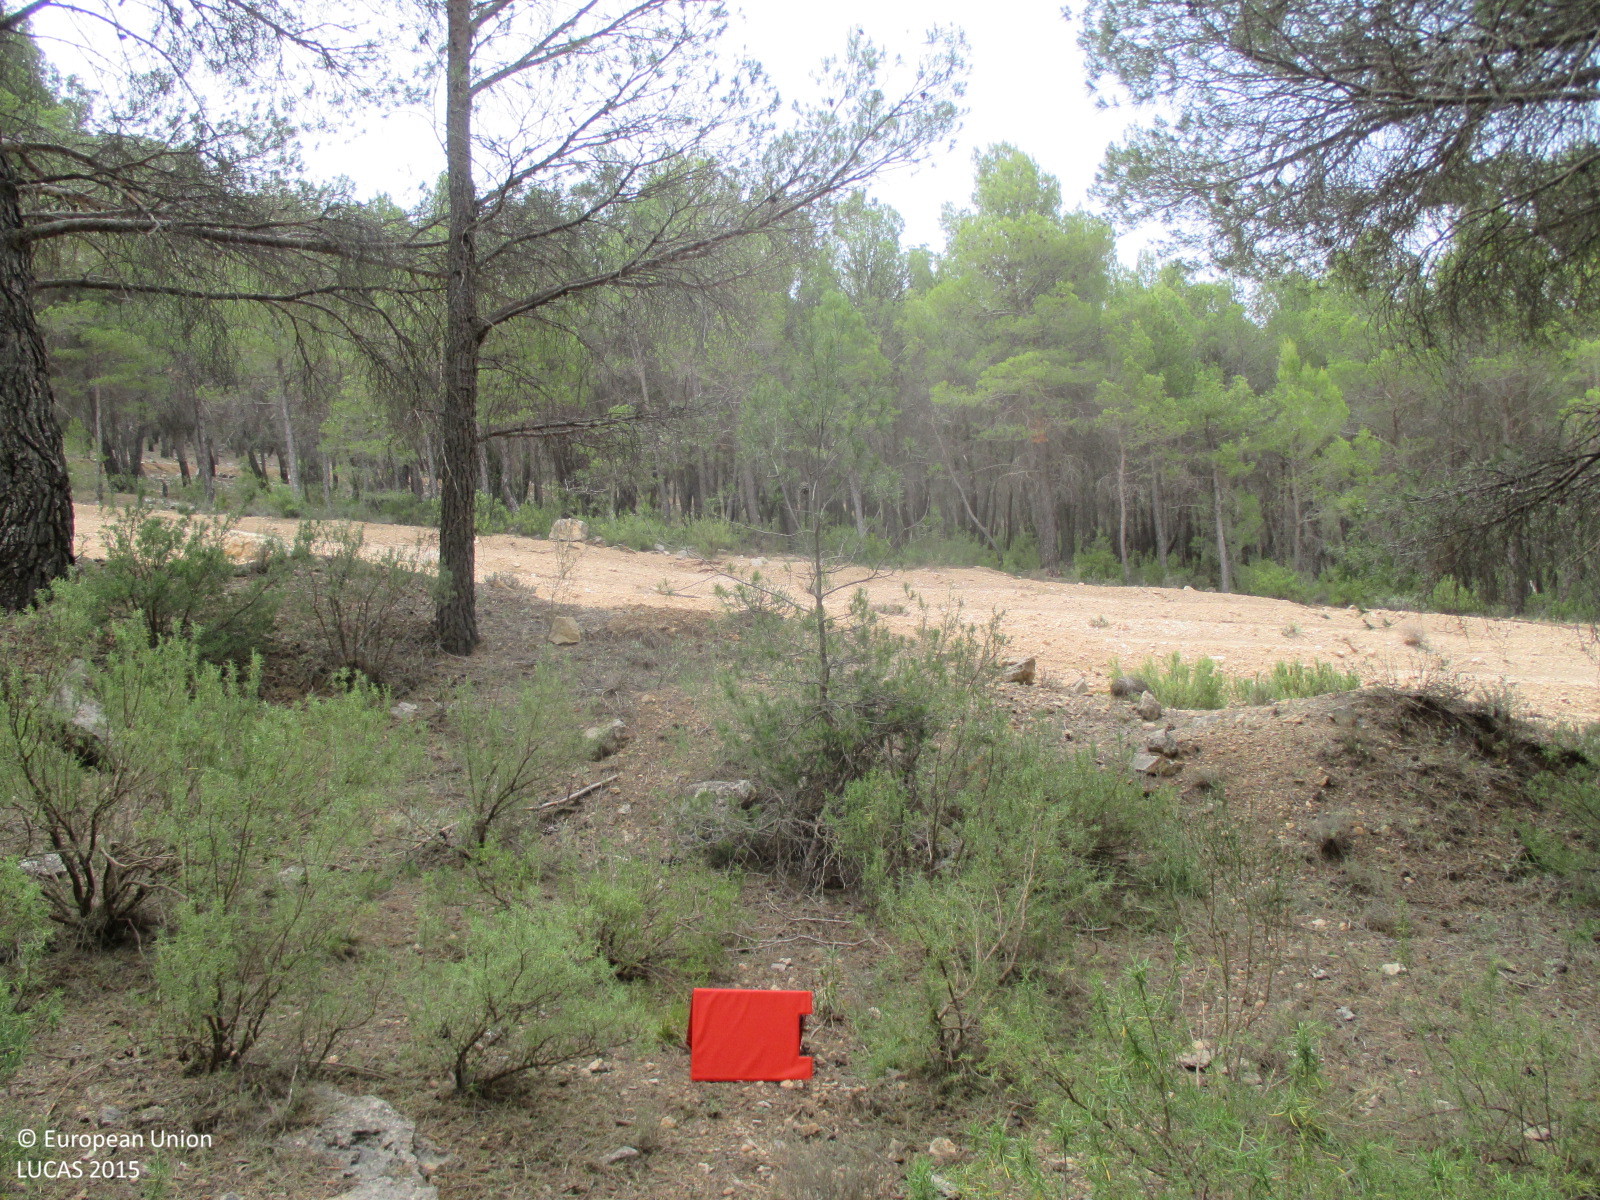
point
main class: Woodland
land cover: Pine dominated coniferous woodland
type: coniferous forest of the mediterranean region
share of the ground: > 75 %
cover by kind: coniferous forest trees 90 %, shrubs 10 %
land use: Forestry
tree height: > 5 m
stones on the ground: < 10 %
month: July
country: ES
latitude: 37.9279
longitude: -2.4943
